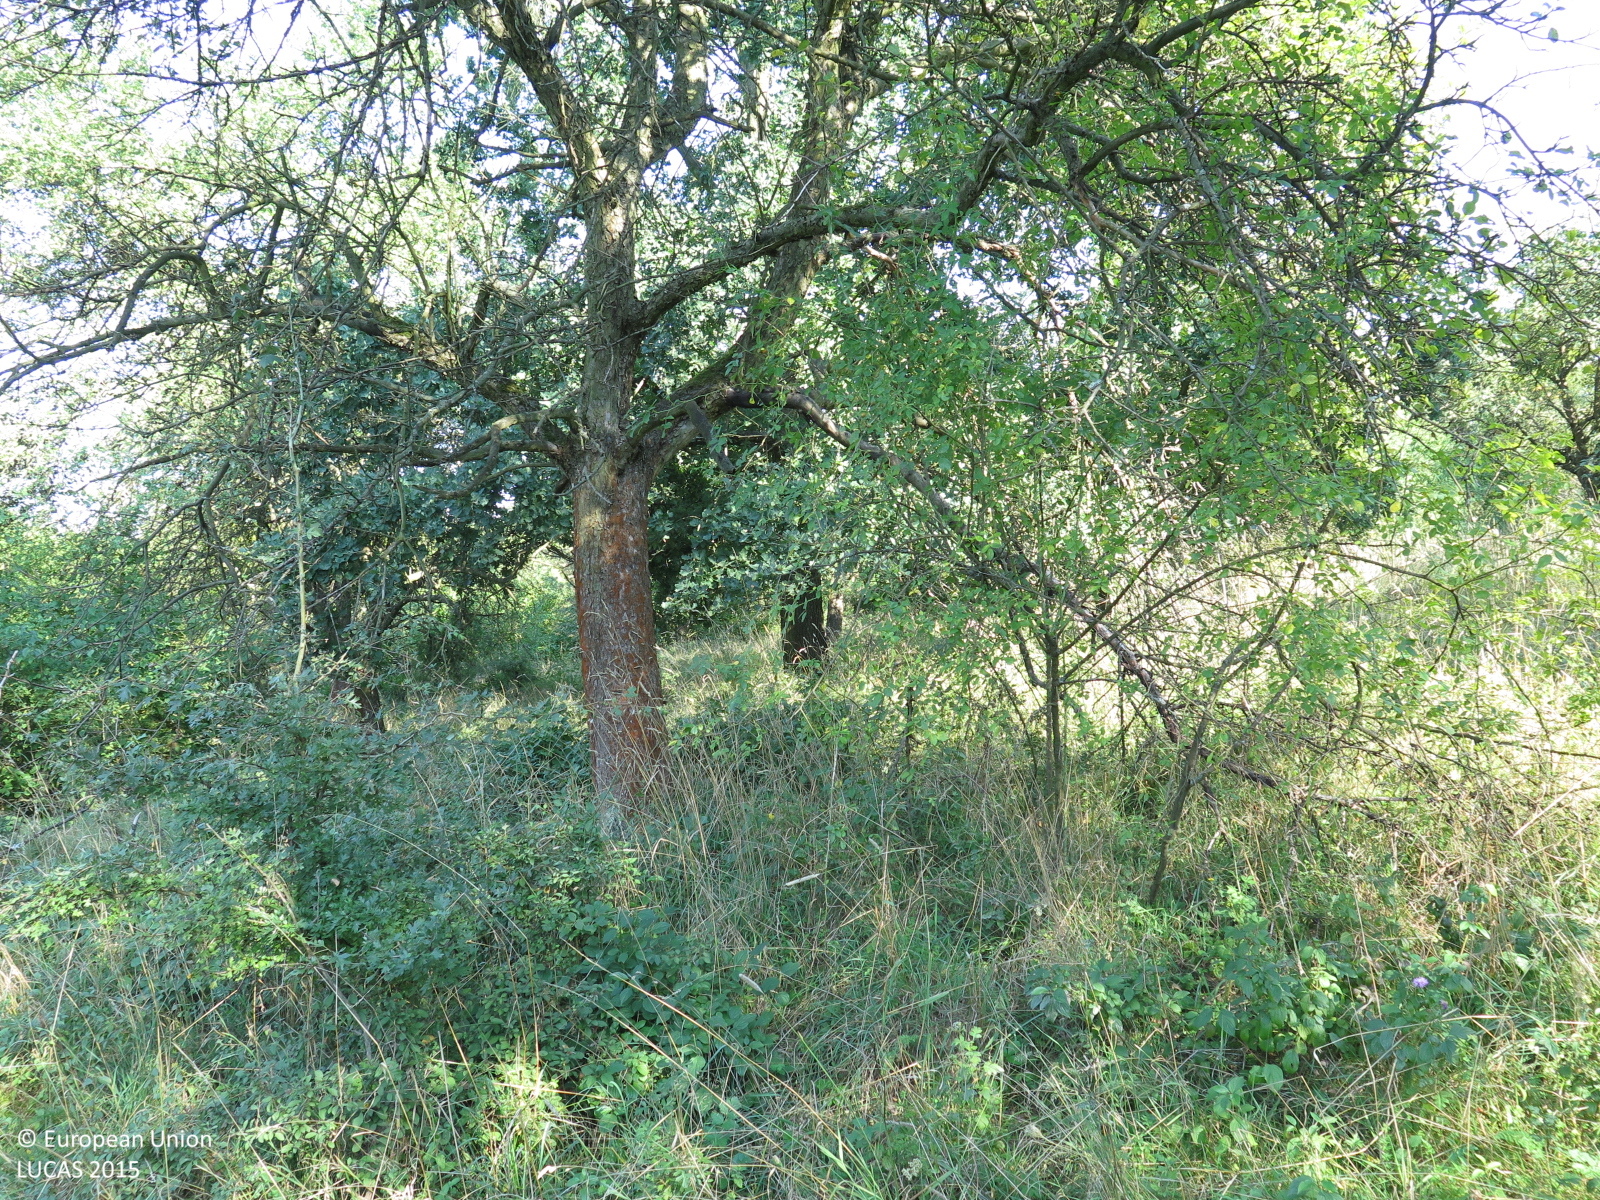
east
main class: Cropland
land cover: Apple fruit
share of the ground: 25 - 50 %
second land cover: Grassland without tree/shrub cover
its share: > 75 %
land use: Abandoned areas
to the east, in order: Apple fruit; Grassland without tree/shrub cover; Other mixed woodland
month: September
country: CZ
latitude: 49.1916
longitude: 17.5727
